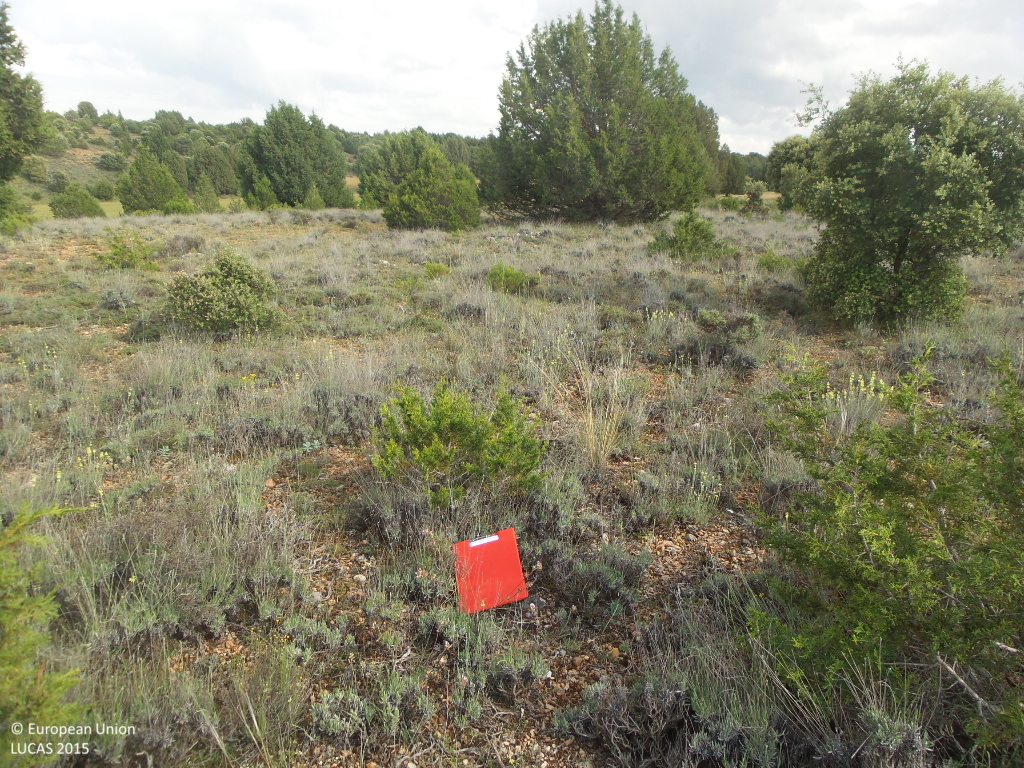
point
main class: Shrubland
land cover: Shrubland with sparse tree cover
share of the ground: 50 - 75 %
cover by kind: shrubs 75 %, herbaceous plants 10 %, unconsolidated bare surface 10 %, coniferous forest trees 5 %
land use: Semi-natural and natural areas not in use
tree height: < 5 m
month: June
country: ES
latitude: 41.3889
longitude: -3.1614
